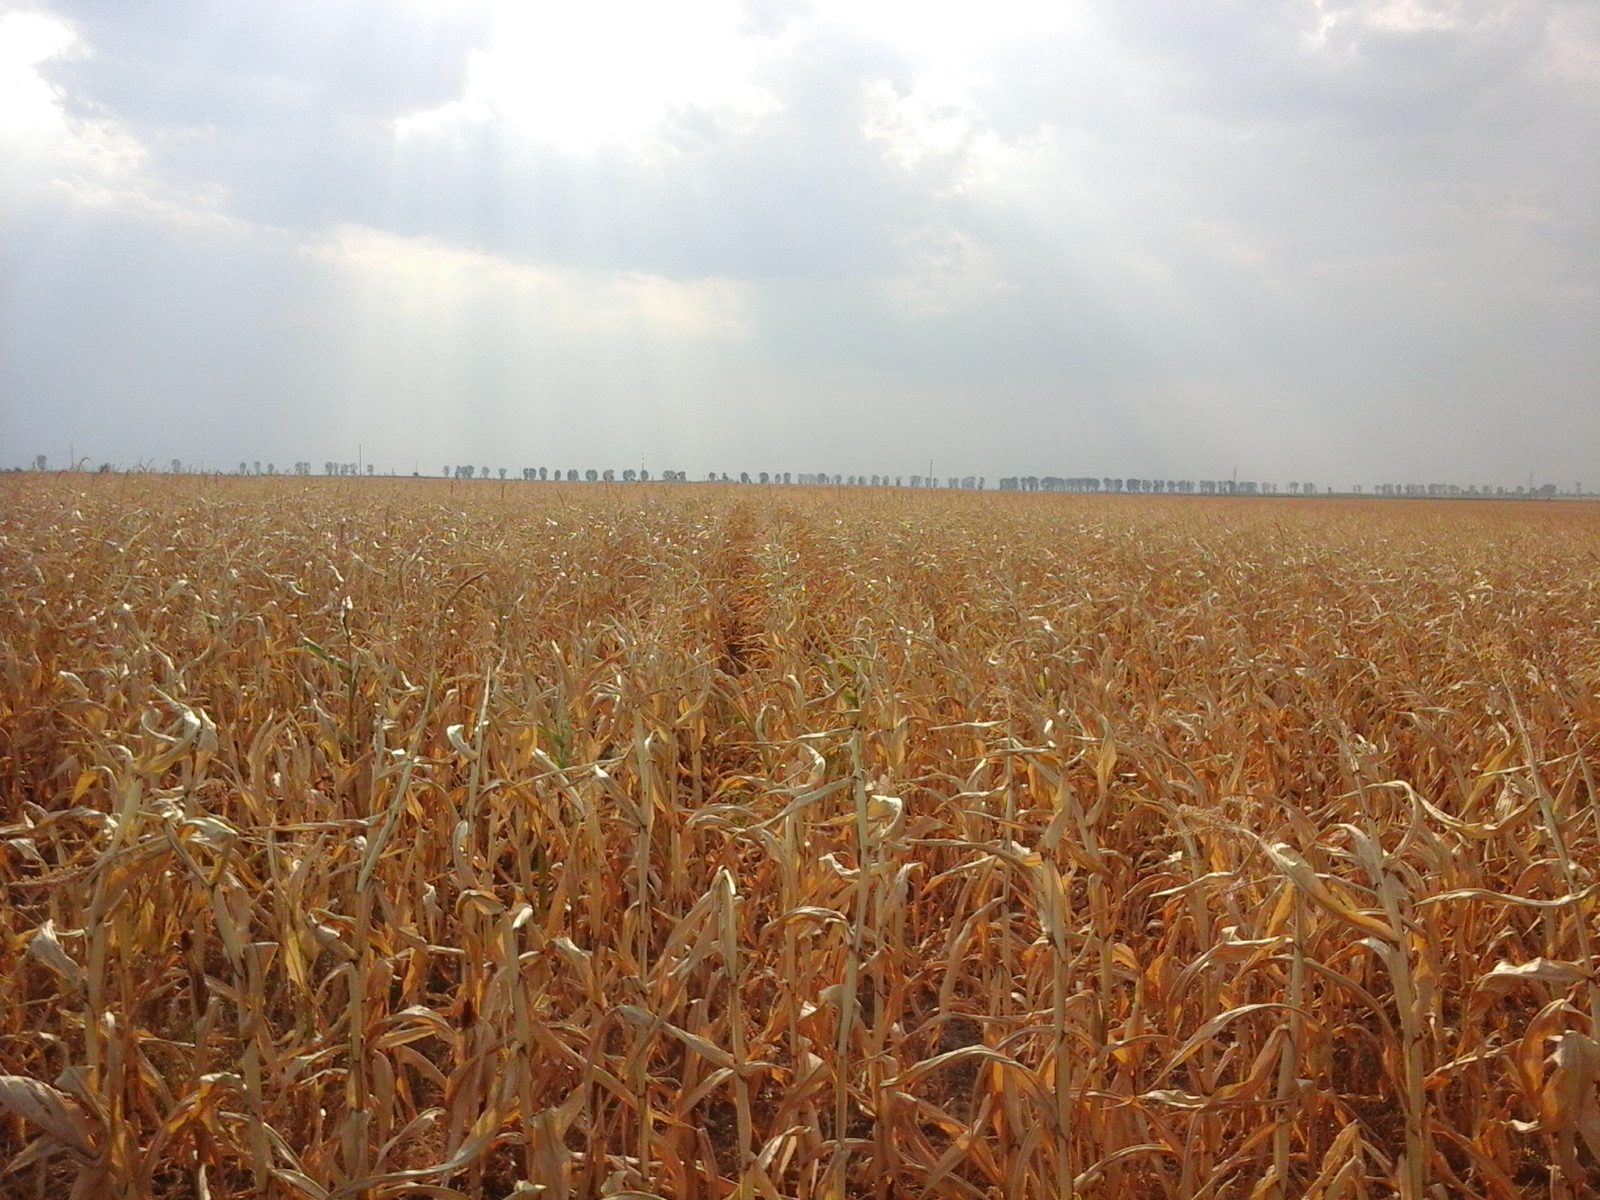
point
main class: Cropland
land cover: Maize
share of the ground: > 75 %
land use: Agriculture (excluding fallow land and kitchen gardens)
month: August
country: RO
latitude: 44.0655
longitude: 23.3687
